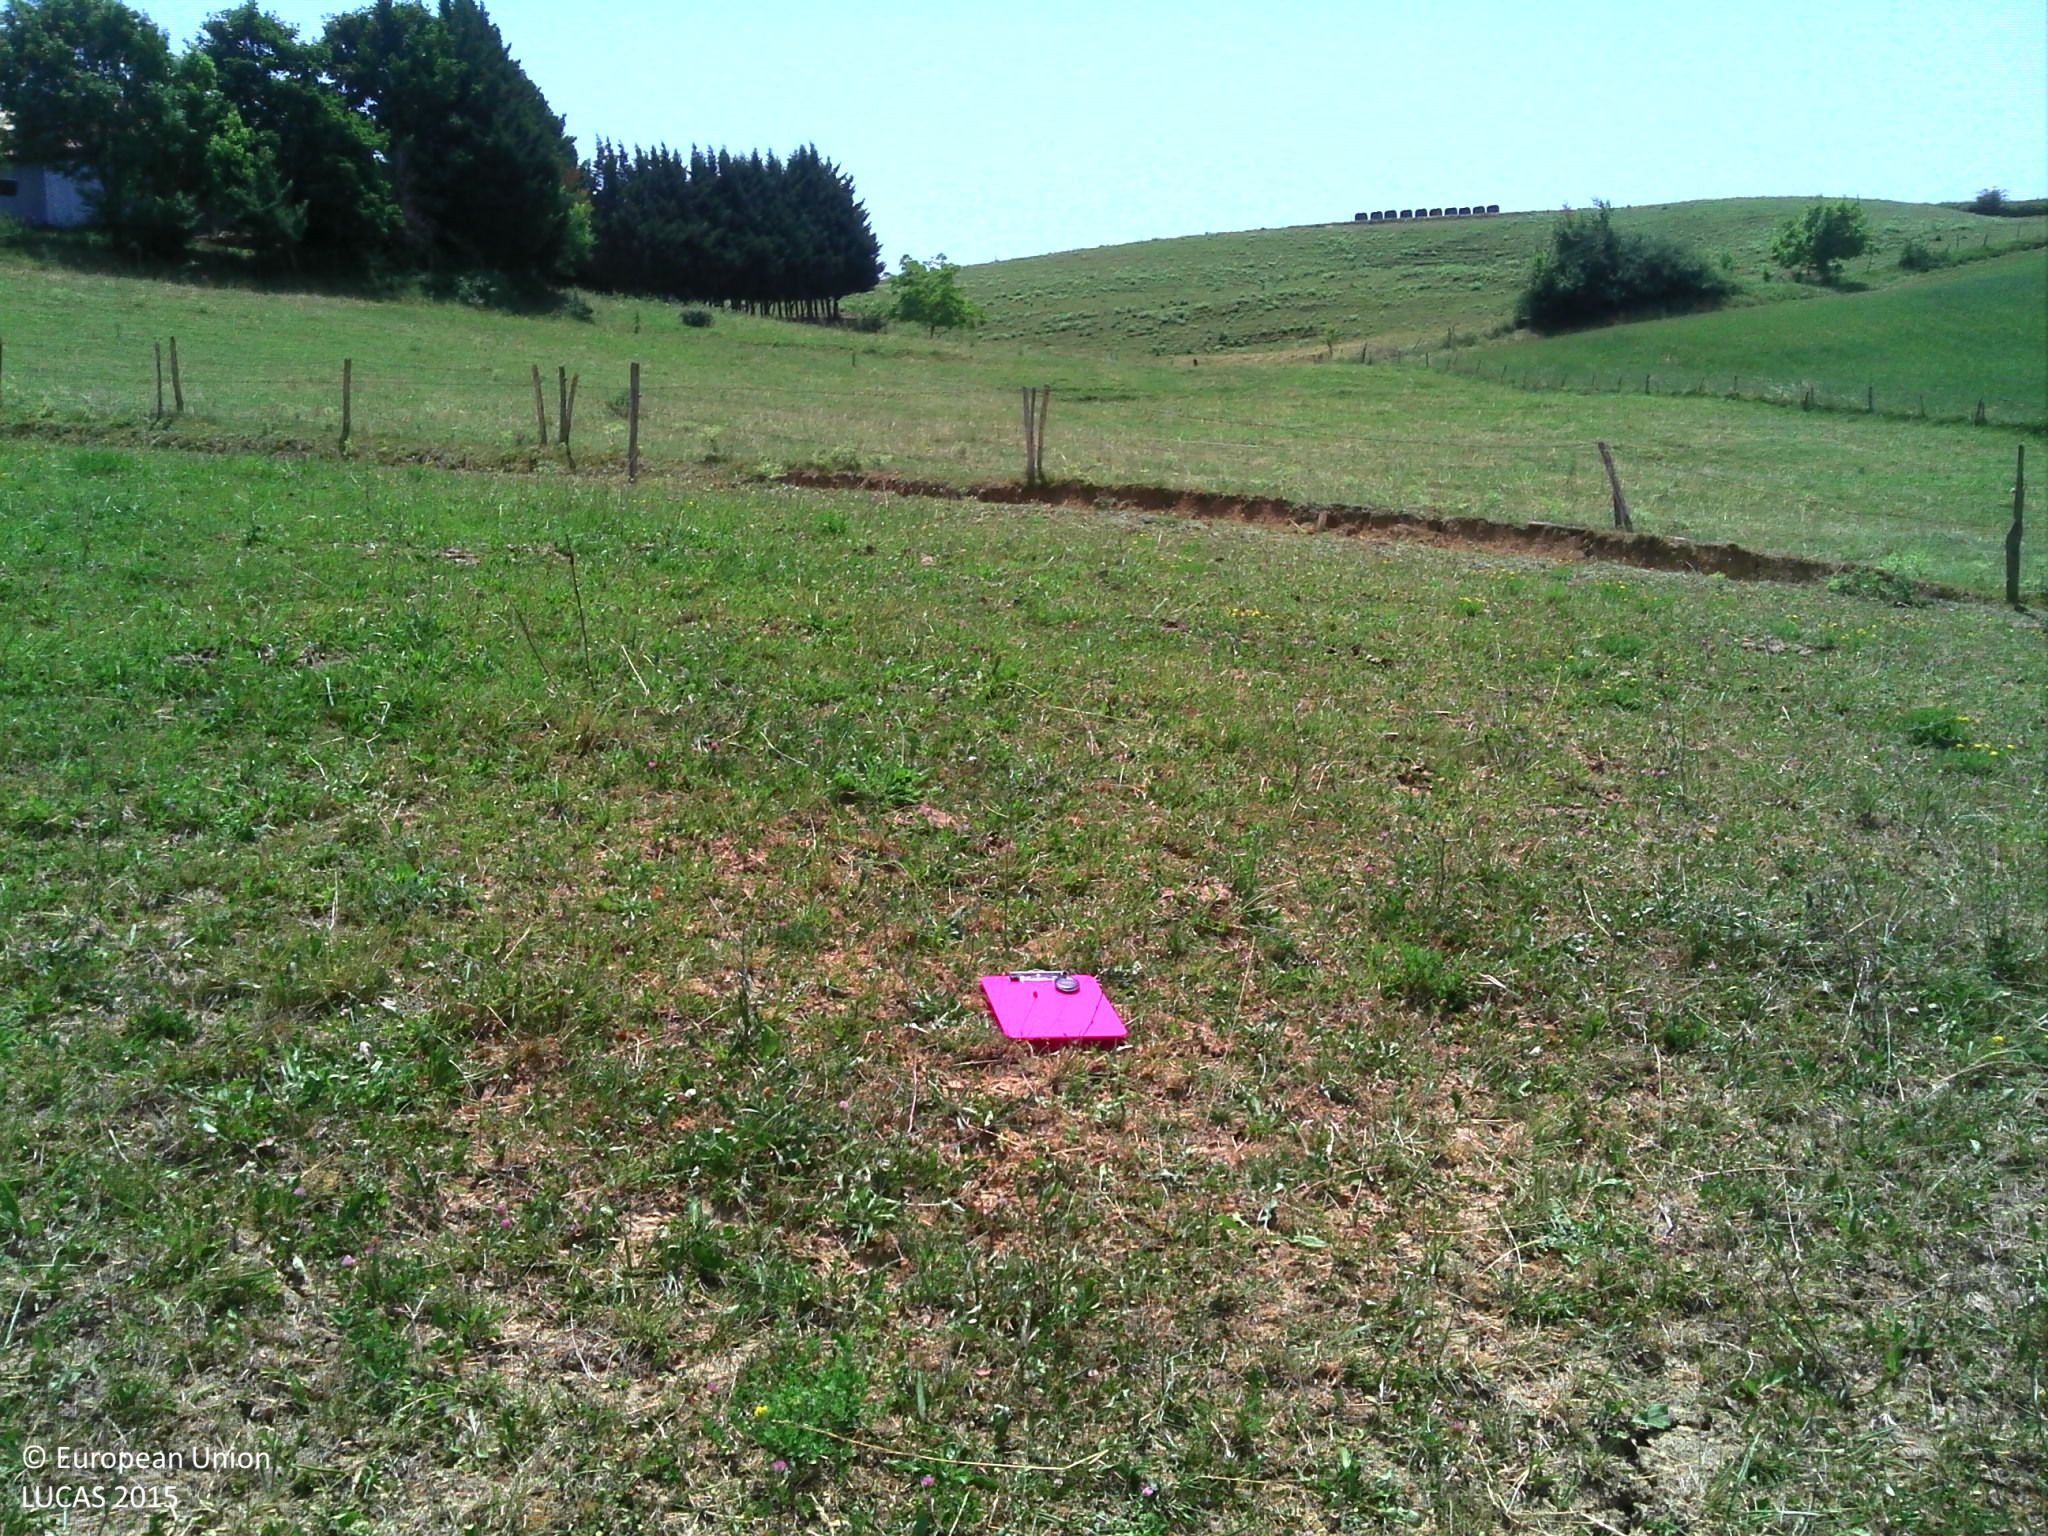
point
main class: Grassland
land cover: Grassland without tree/shrub cover
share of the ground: > 75 %
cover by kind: herbaceous plants 100 %
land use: Agriculture (excluding fallow land and kitchen gardens)
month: July
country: FR
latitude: 43.1236
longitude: 1.4135
